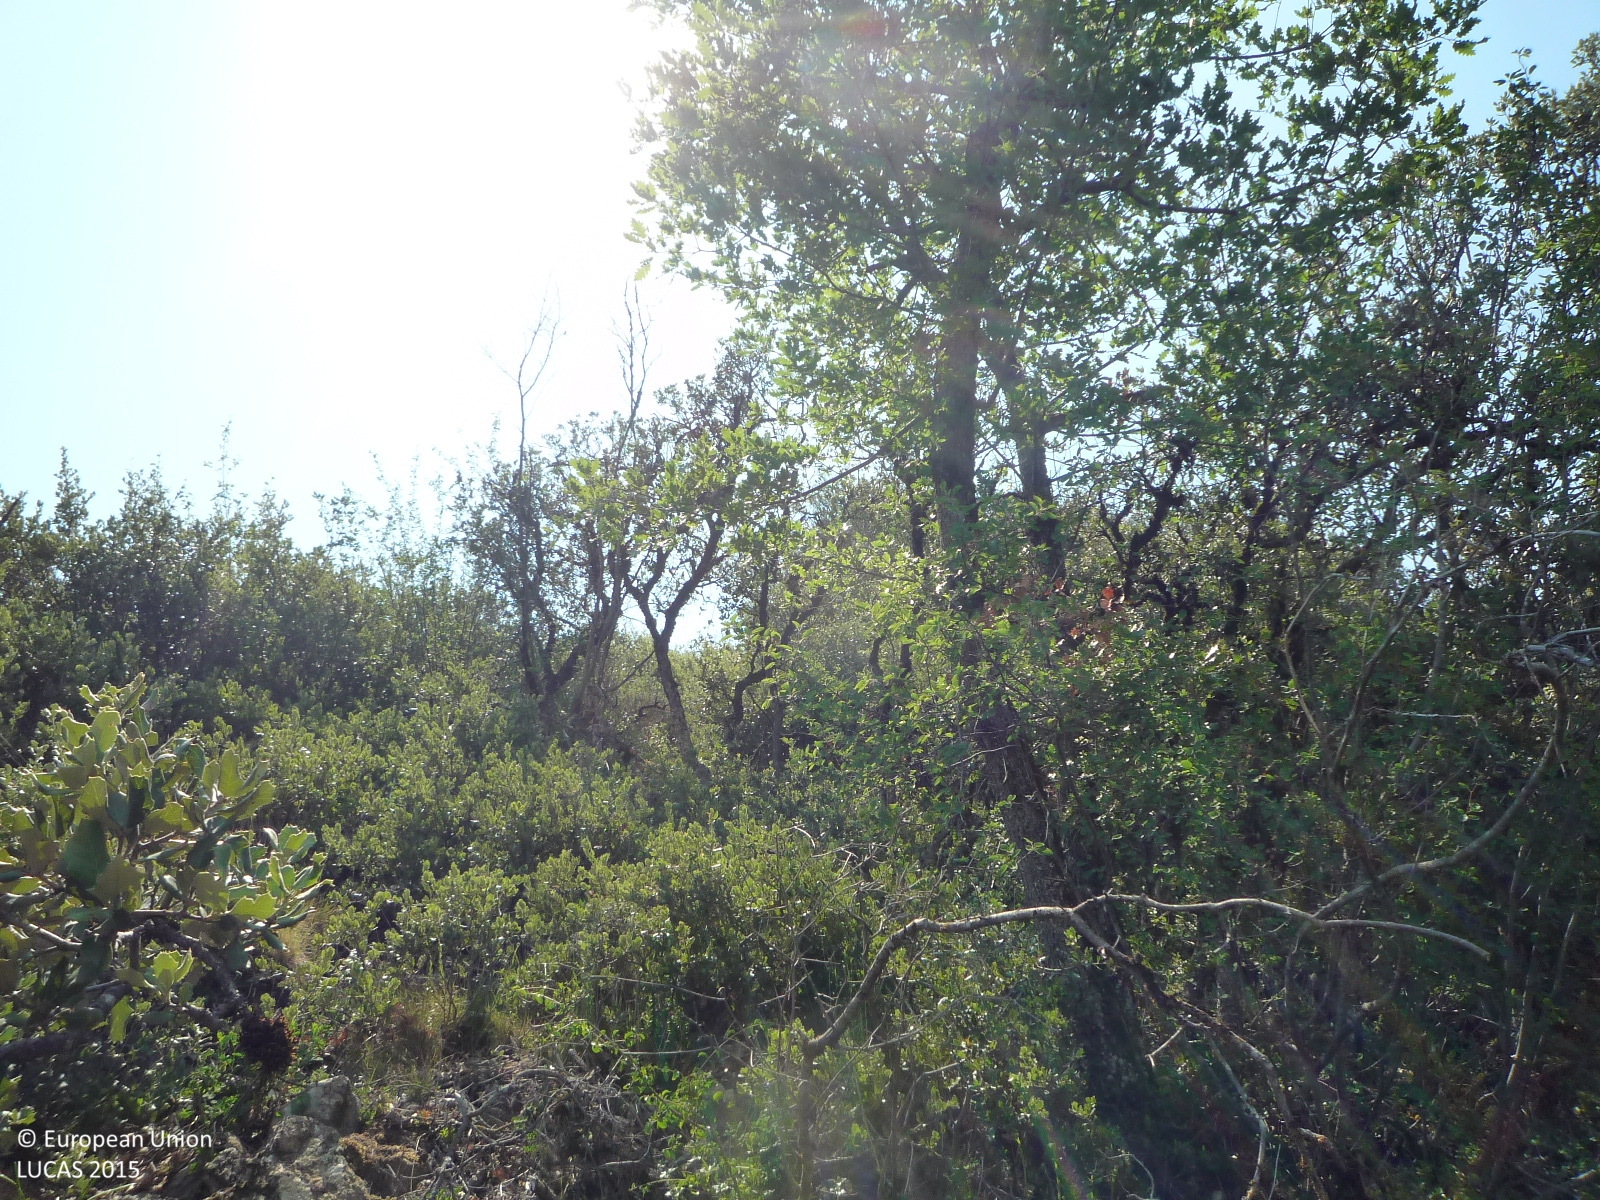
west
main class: Woodland
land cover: Pine dominated mixed woodland
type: alpine coniferous forest
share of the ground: > 75 %
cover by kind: broadleaved forest trees 40 %, coniferous forest trees 30 %, shrubs 20 %, consolidated bare surface 10 %
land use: Semi-natural and natural areas not in use
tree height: < 5 m
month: June
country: ES
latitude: 42.3767
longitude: 1.5941
